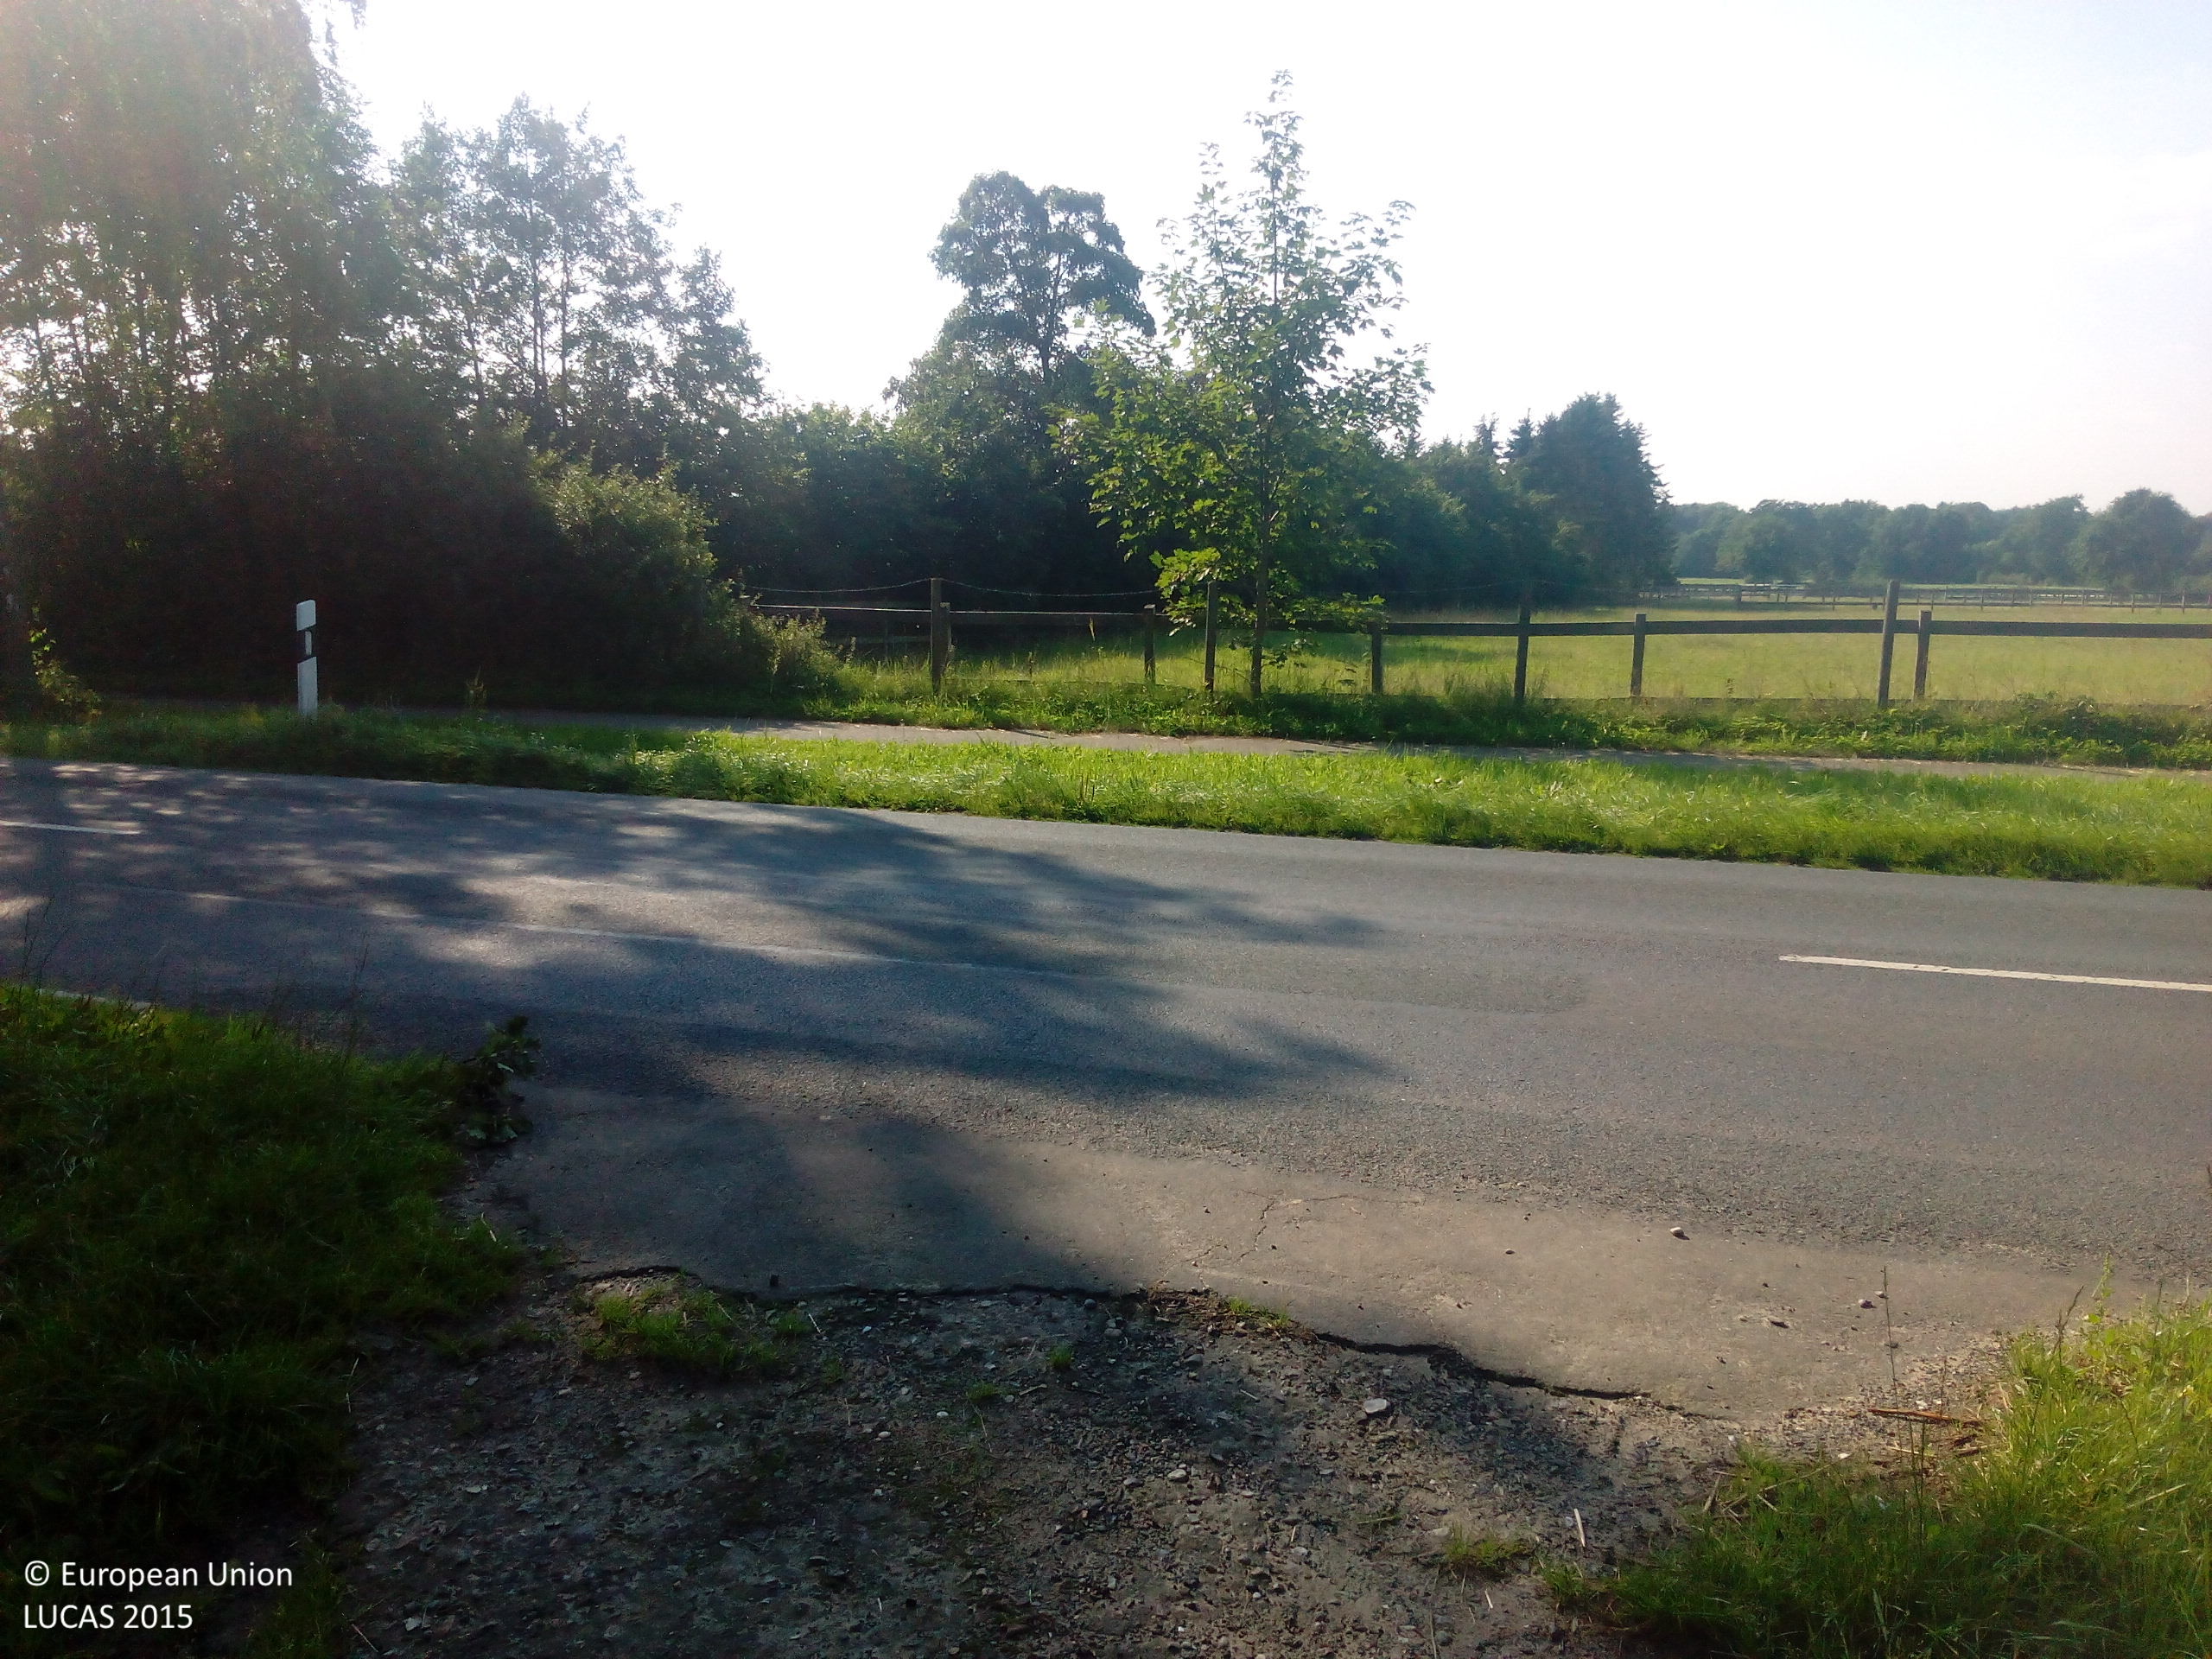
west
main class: Cropland
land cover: Maize
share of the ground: > 75 %
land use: Agriculture (excluding fallow land and kitchen gardens)
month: August
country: DE
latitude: 53.6894
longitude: 9.8638
